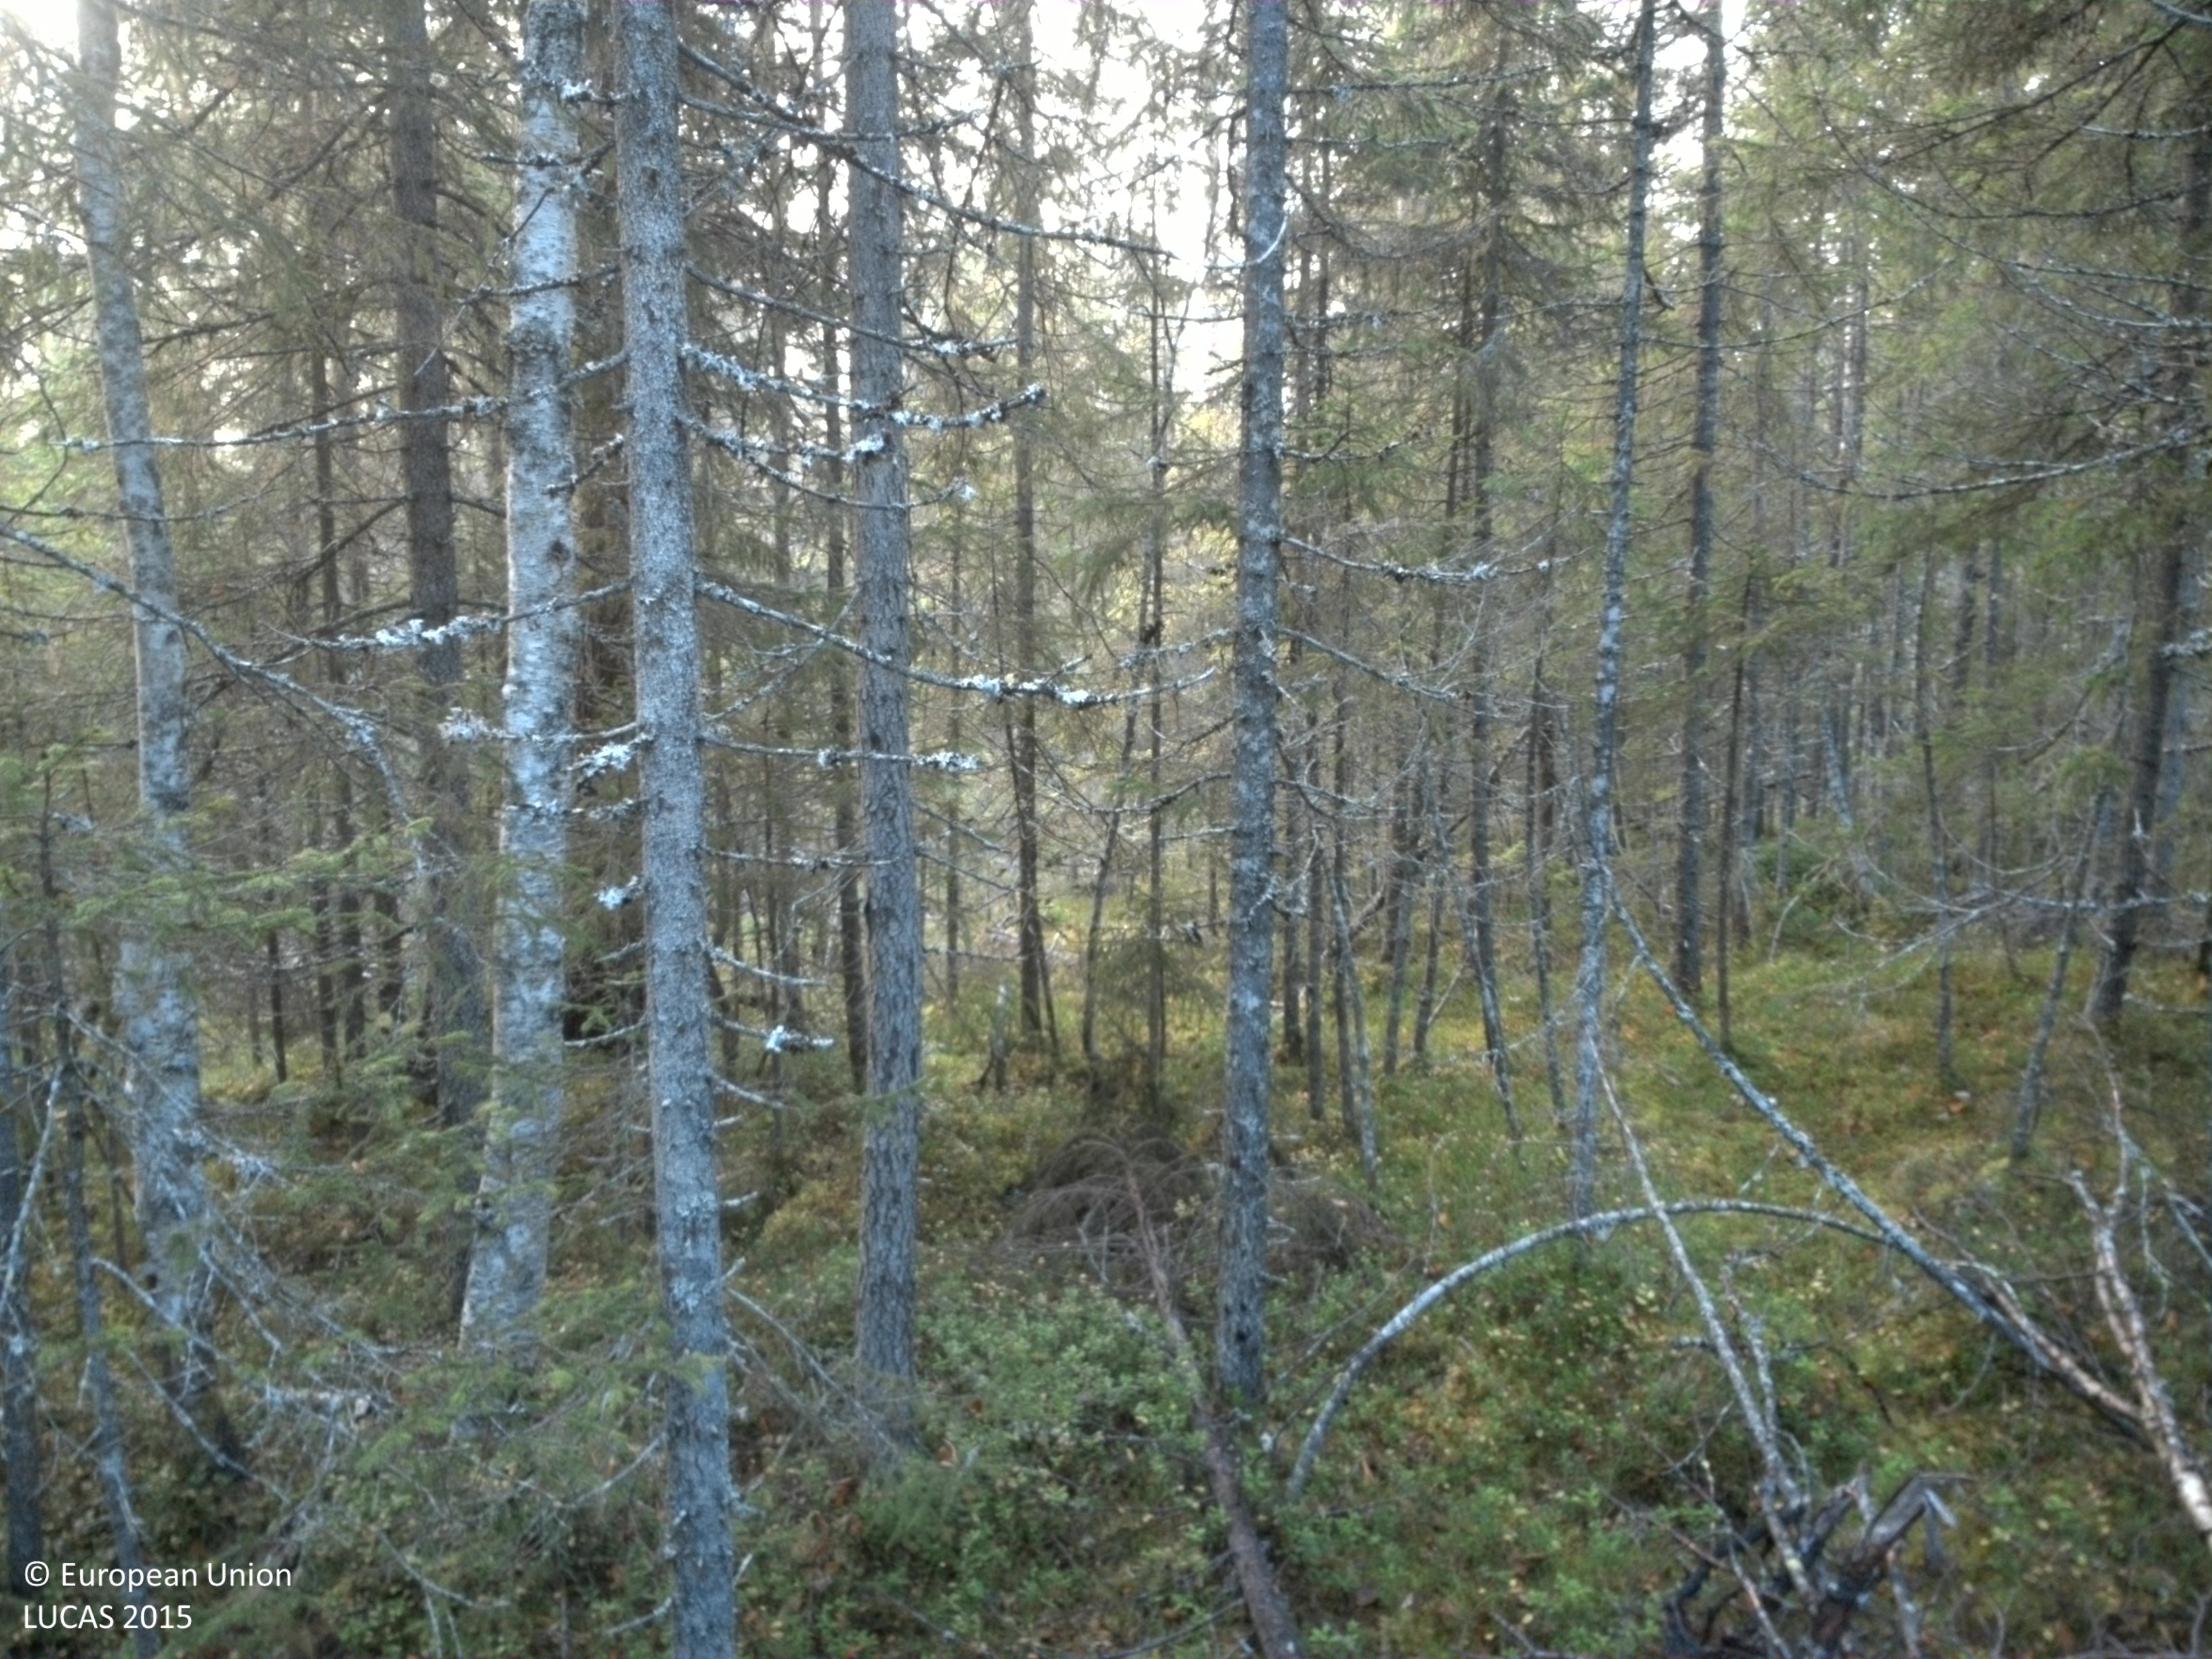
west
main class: Woodland
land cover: Spruce dominated coniferous woodland
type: boreal forest
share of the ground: 50 - 75 %
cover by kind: coniferous forest trees 65 %, shrubs 15 %, herbaceous plants 15 %, broadleaved forest trees 5 %
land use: Forestry
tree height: > 5 m
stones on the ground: < 10 %
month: October
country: SE
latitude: 64.5483
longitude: 16.6619
